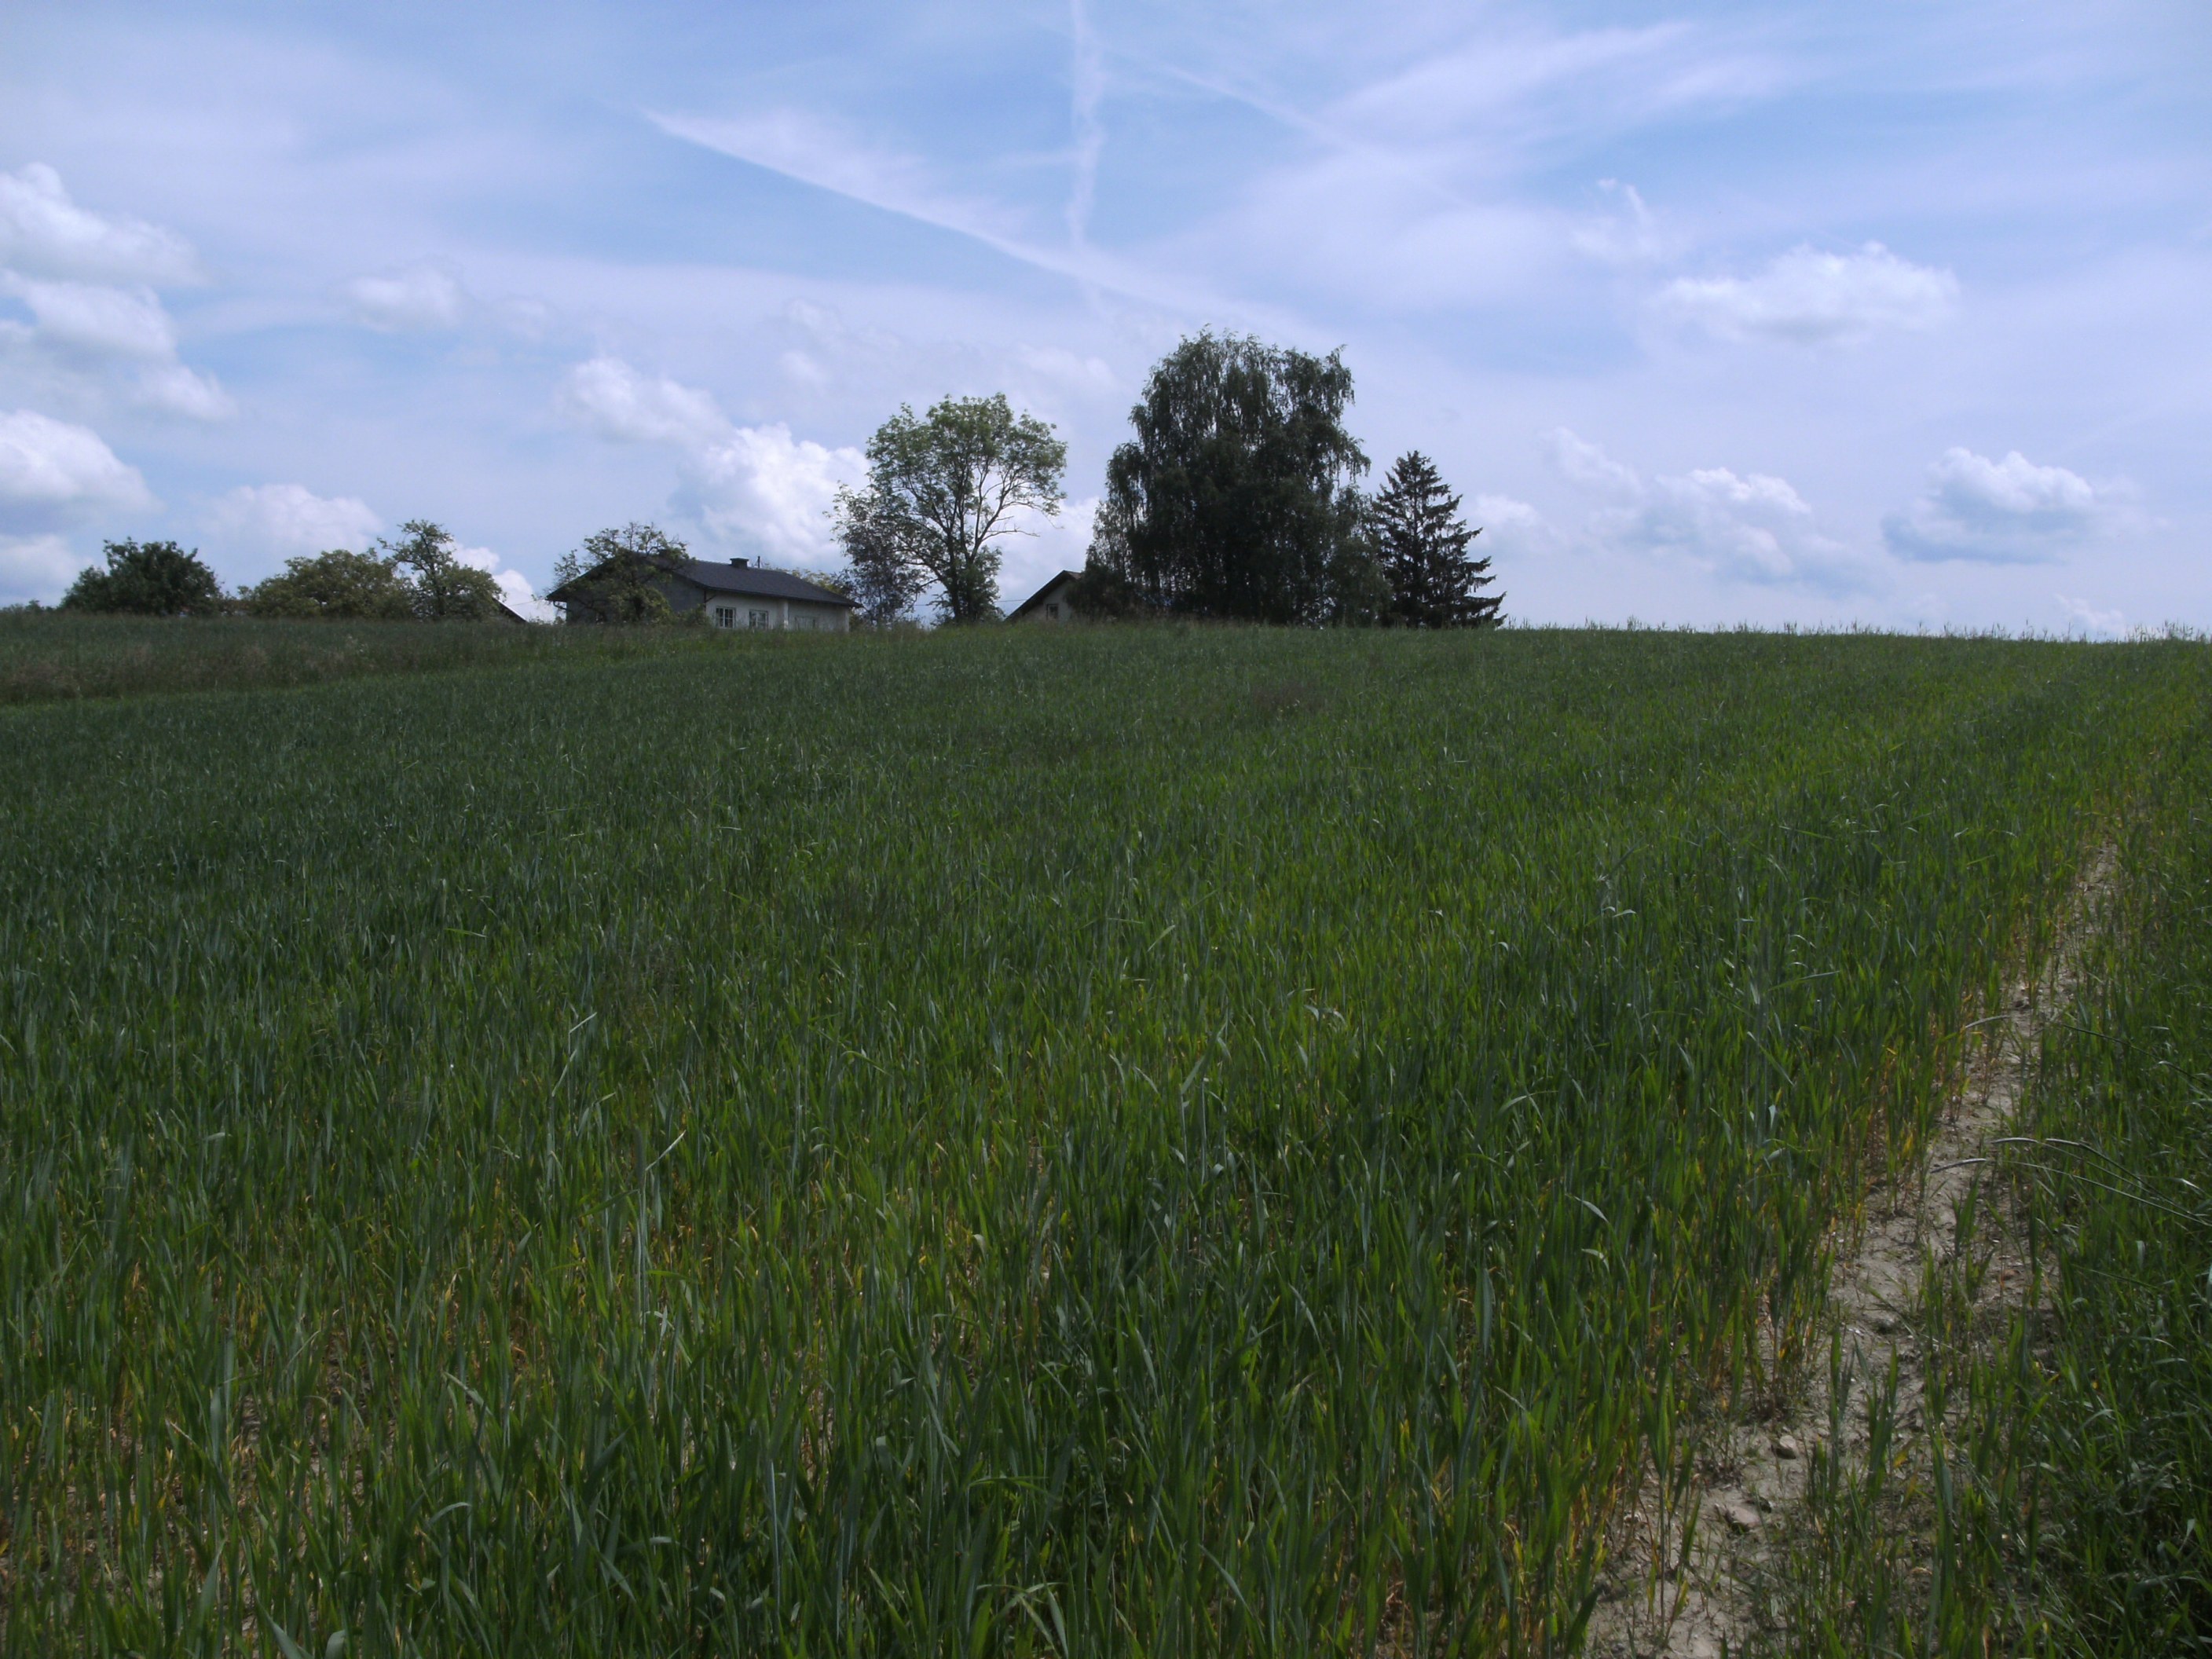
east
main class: Cropland
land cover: Triticale
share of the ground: > 75 %
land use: Agriculture (excluding fallow land and kitchen gardens)
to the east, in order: Triticale; Grass margins; Common wheat; Grassland with sparse tree/shrub cover; Artificial constructions in urban areas; Grassland without tree/shrub cover
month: June
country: AT
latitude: 48.0599
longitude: 13.5012
